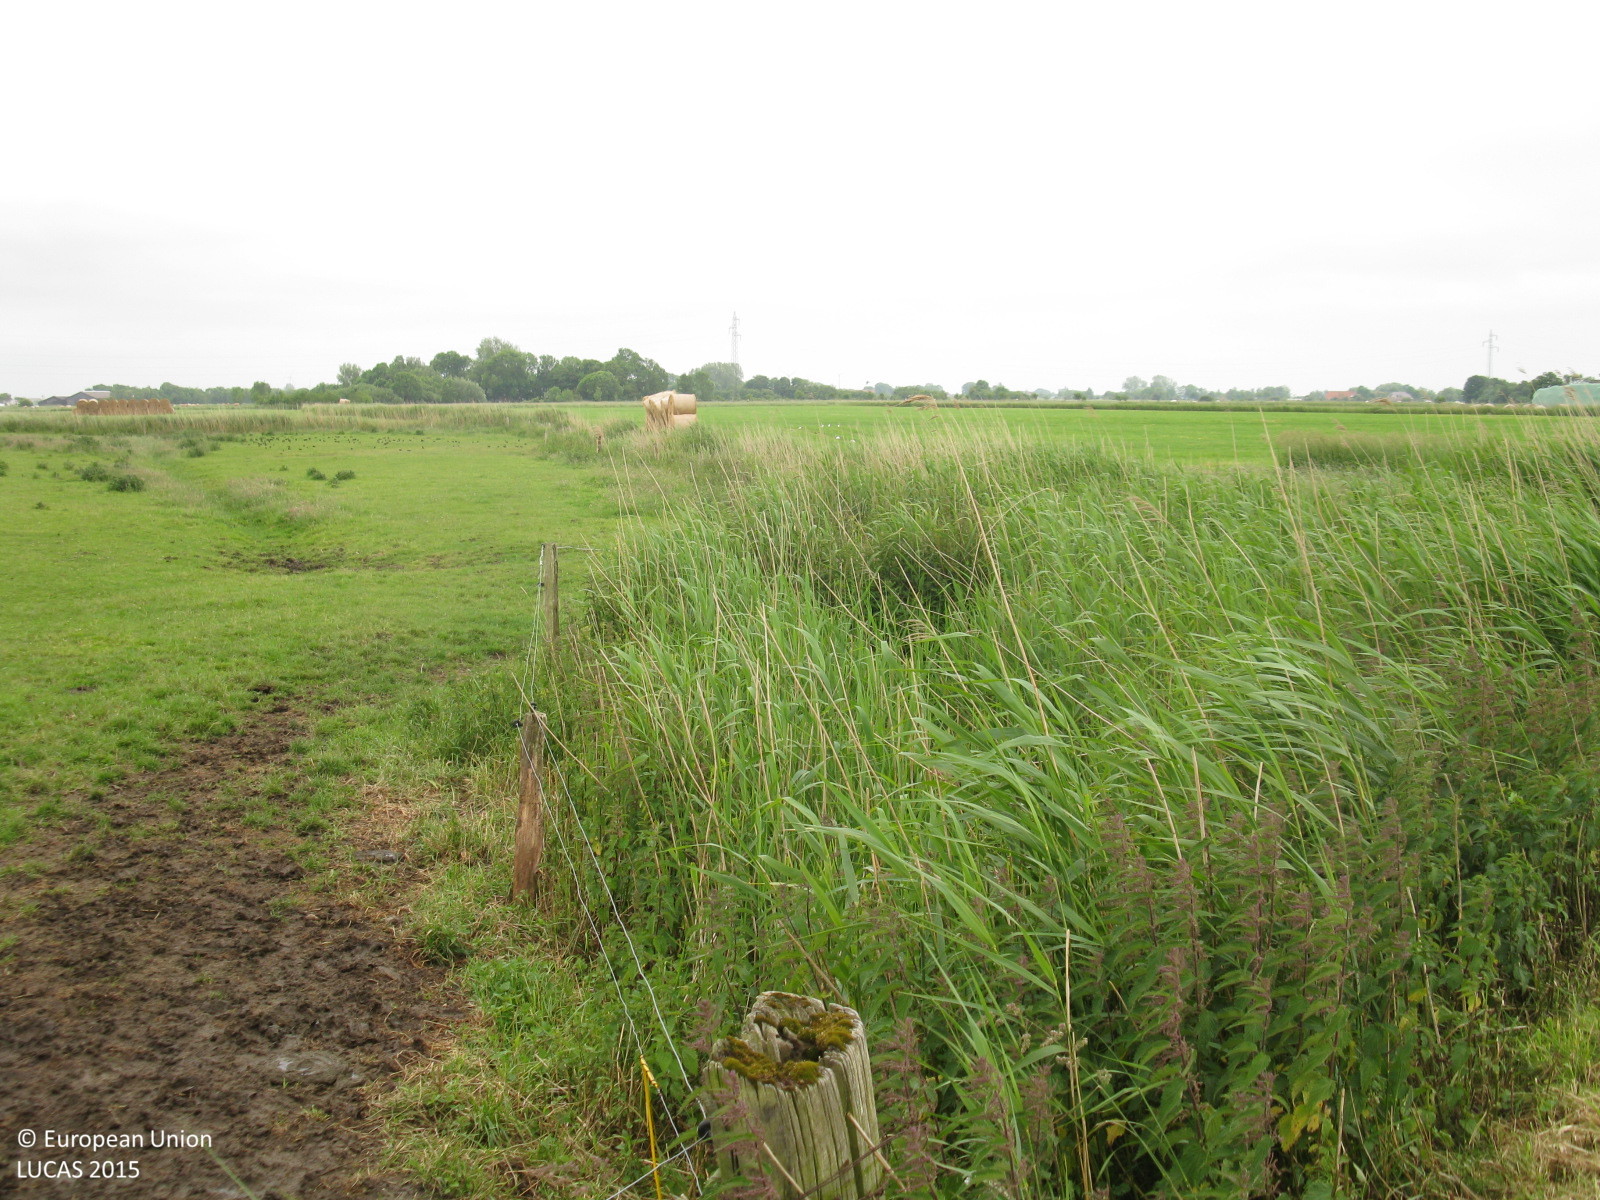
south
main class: Grassland
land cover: Grassland without tree/shrub cover
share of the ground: > 75 %
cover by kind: herbaceous plants 100 %
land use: Agriculture (excluding fallow land and kitchen gardens)
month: June
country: DE
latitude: 53.6534
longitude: 7.8977
